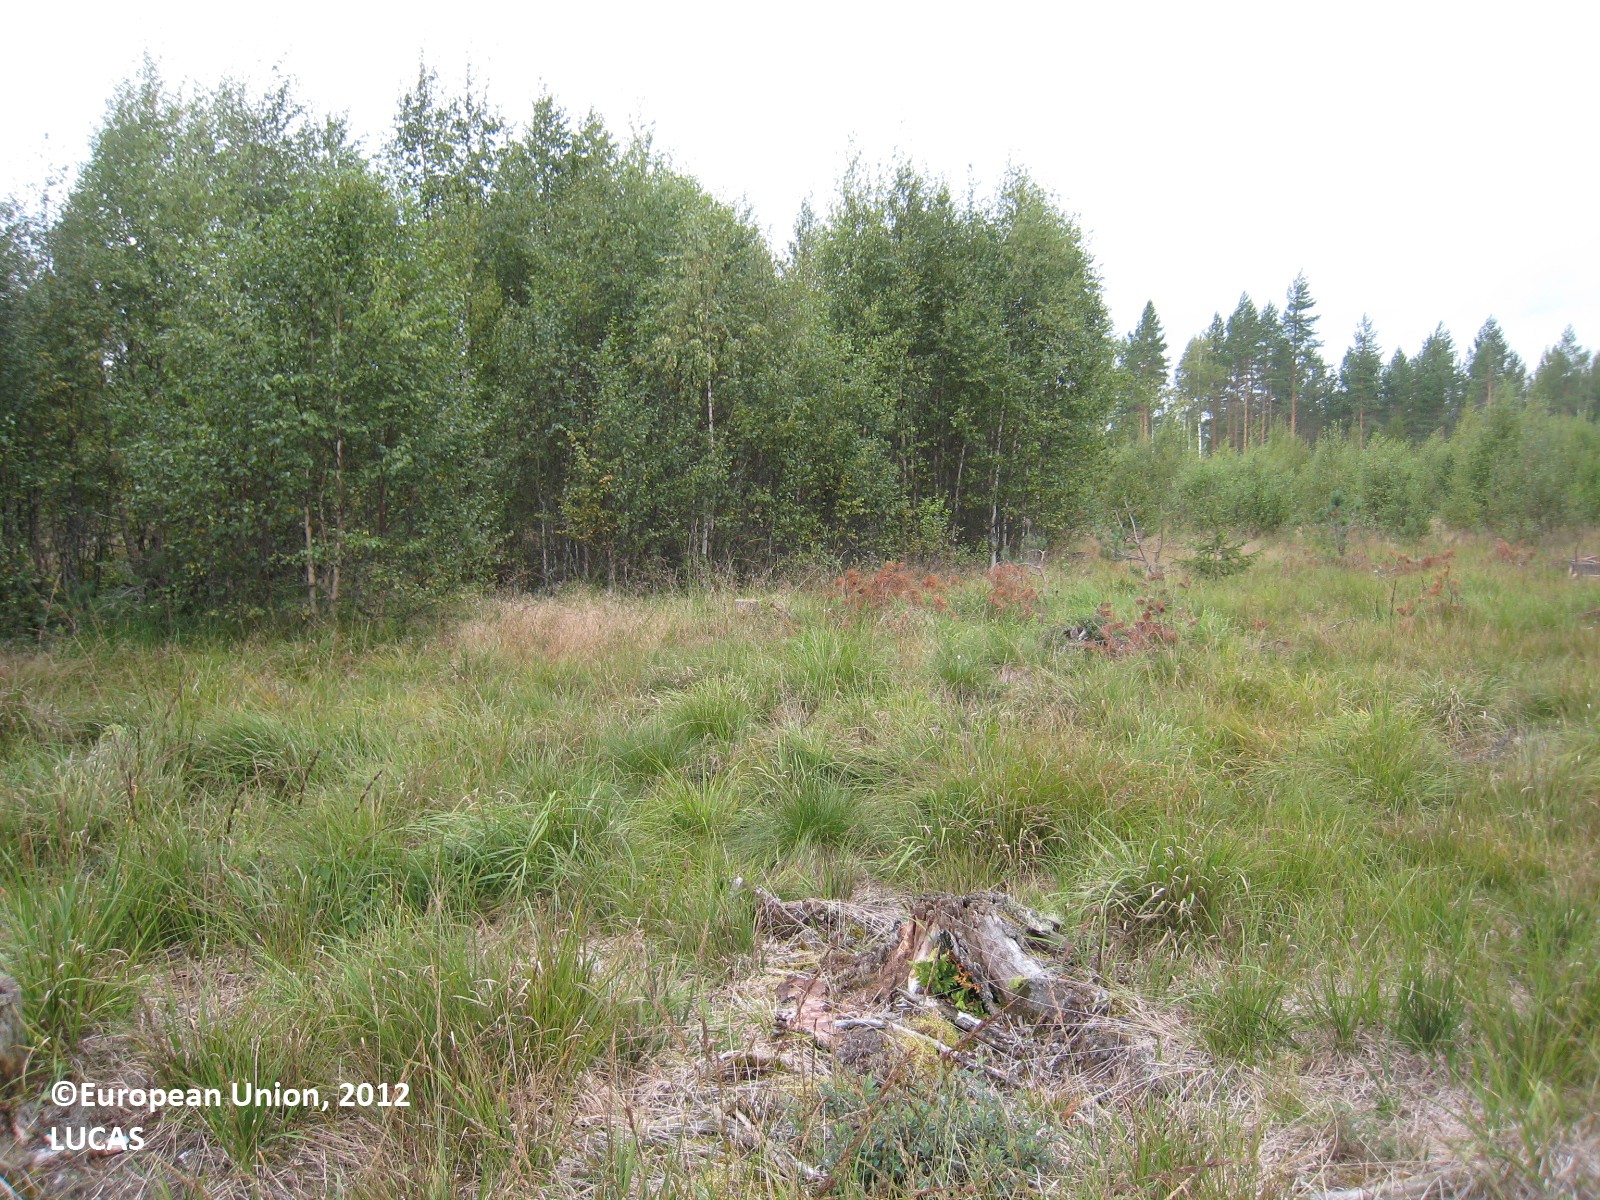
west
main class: Grassland
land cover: Grassland with sparse tree/shrub cover
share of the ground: > 75 %
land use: Forestry
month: August
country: FI
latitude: 61.8548
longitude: 26.0373
